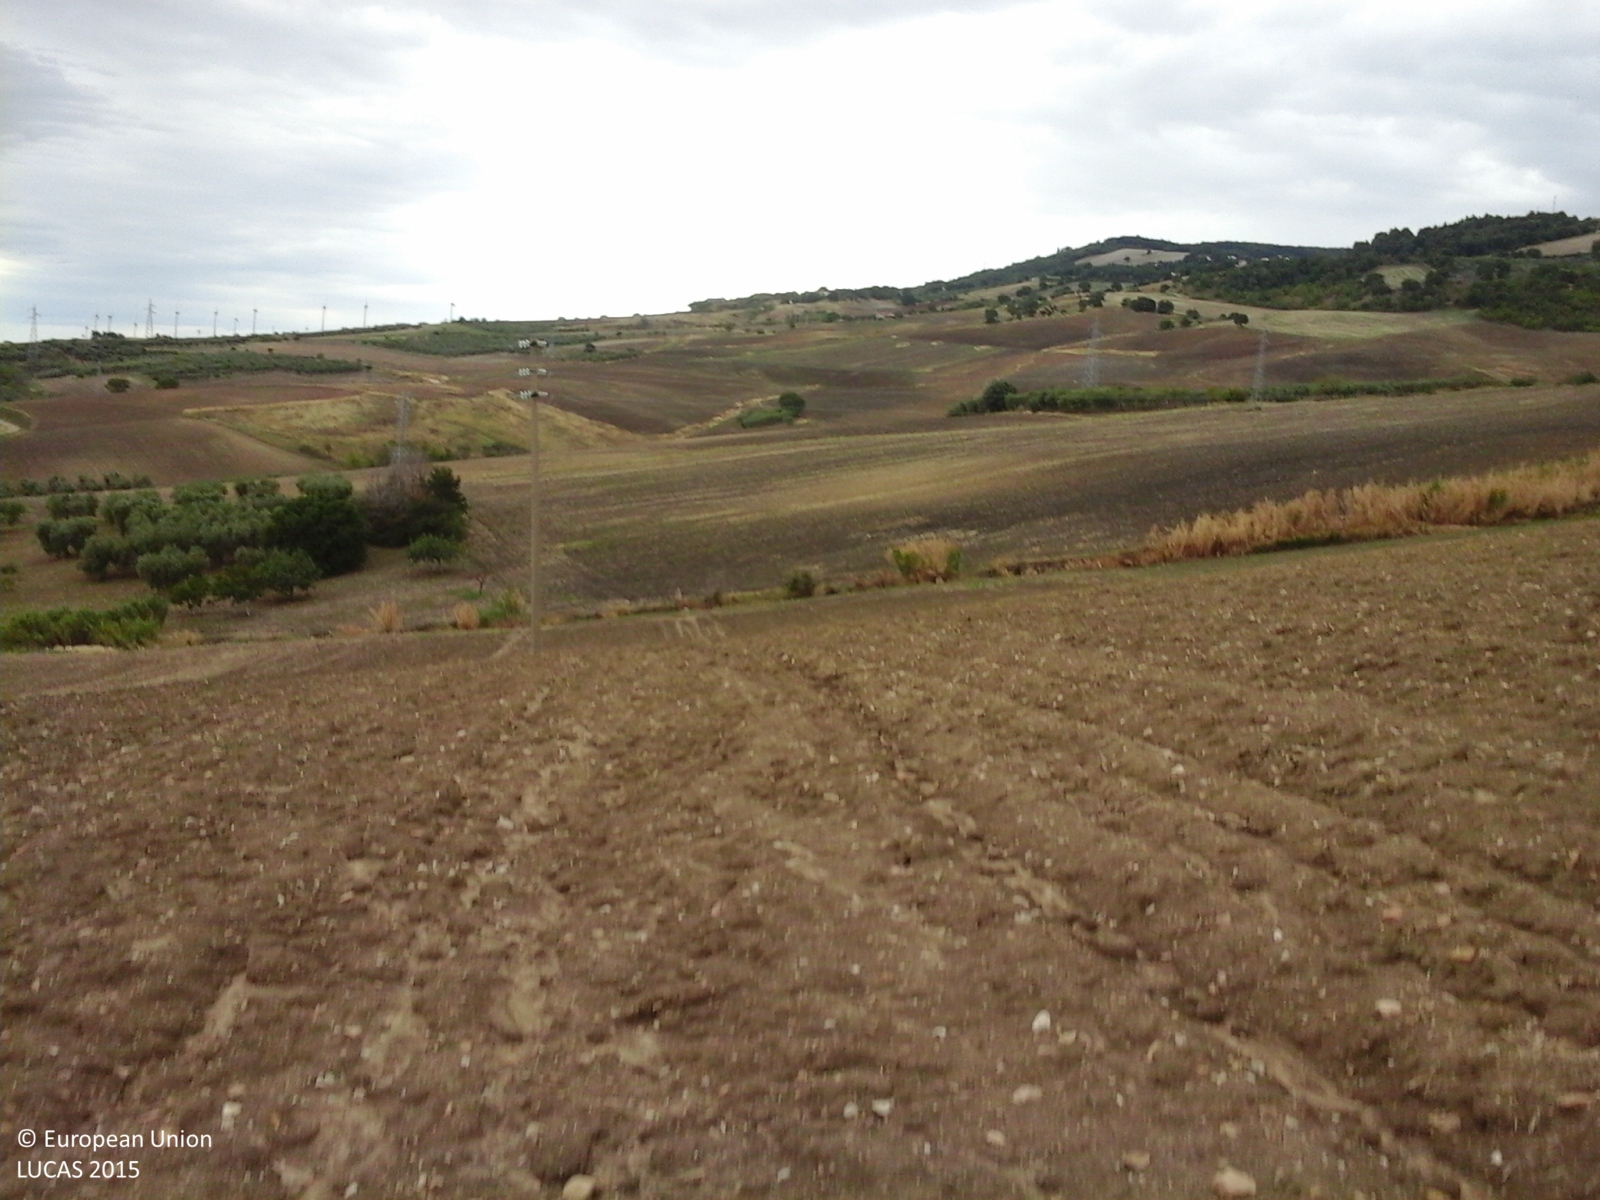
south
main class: Cropland
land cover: Barley
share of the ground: > 75 %
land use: Agriculture (excluding fallow land and kitchen gardens)
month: October
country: IT
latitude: 41.6009
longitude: 15.1303
